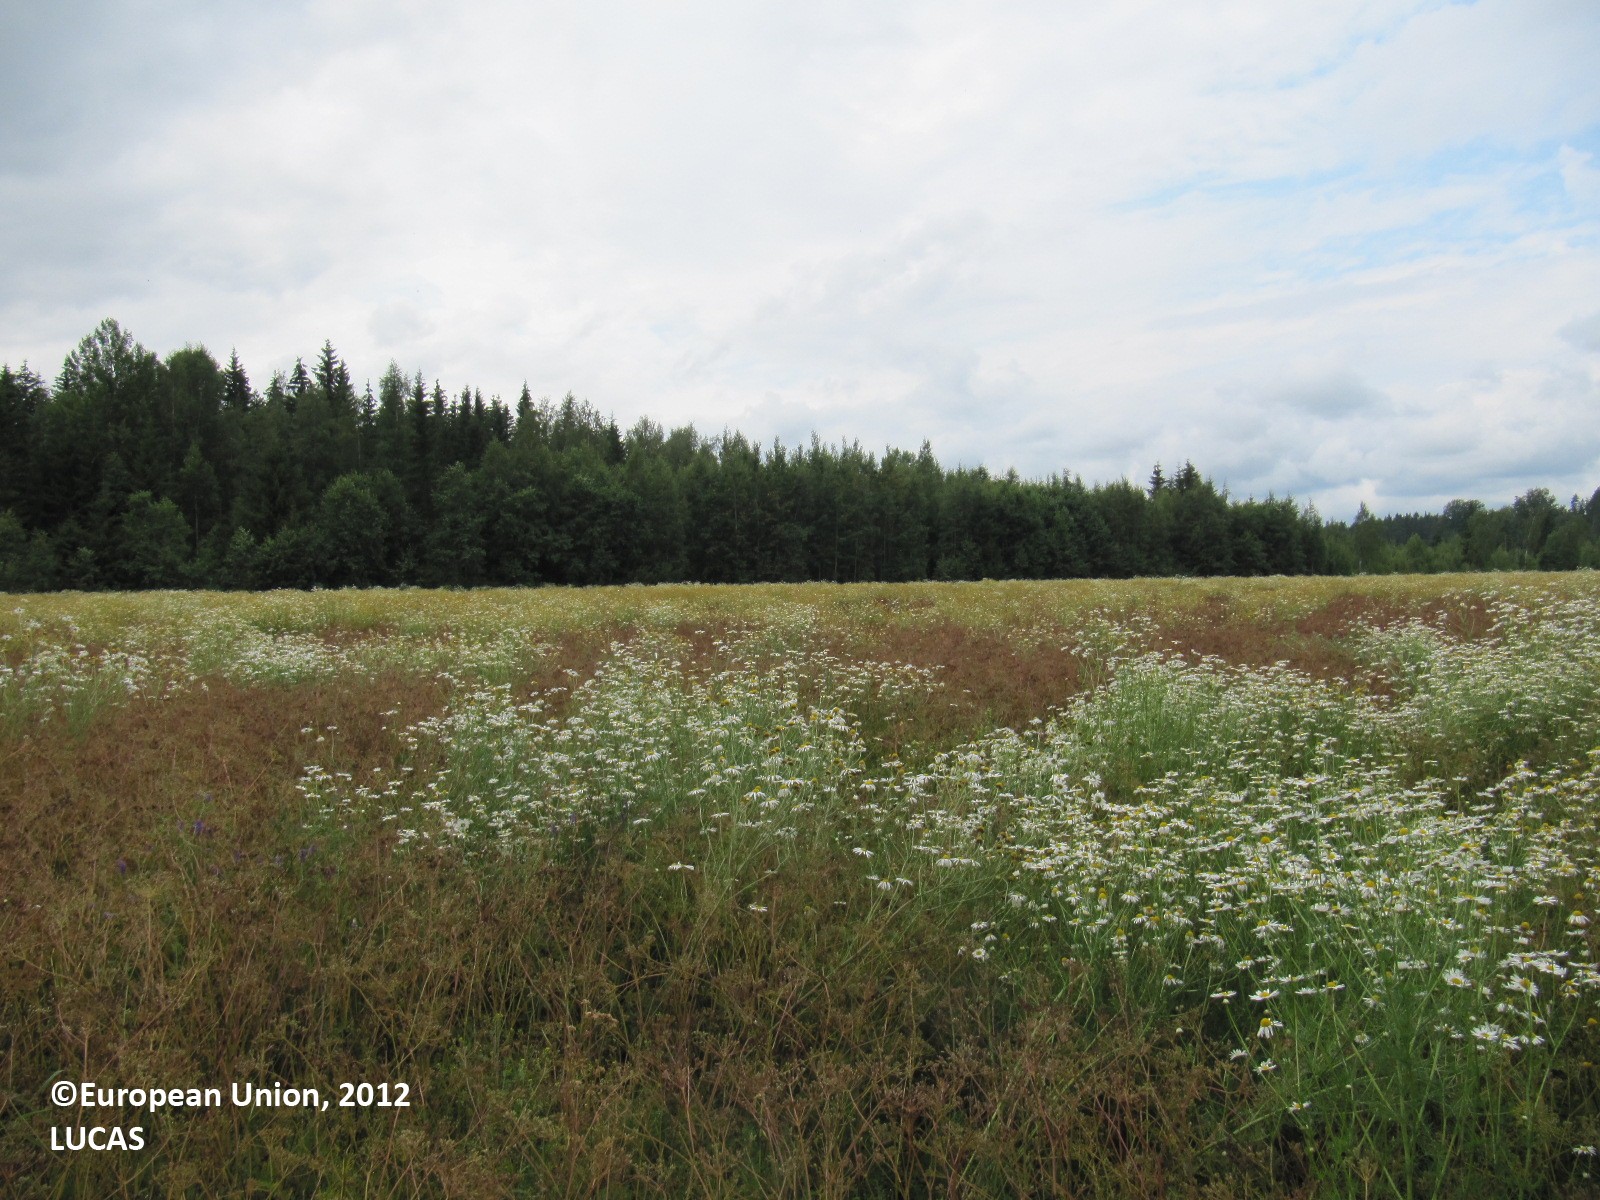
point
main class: Cropland
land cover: Other non-permanent industrial crops
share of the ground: > 75 %
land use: Agriculture (excluding fallow land and kitchen gardens)
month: July
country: FI
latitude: 60.7219
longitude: 23.2609
